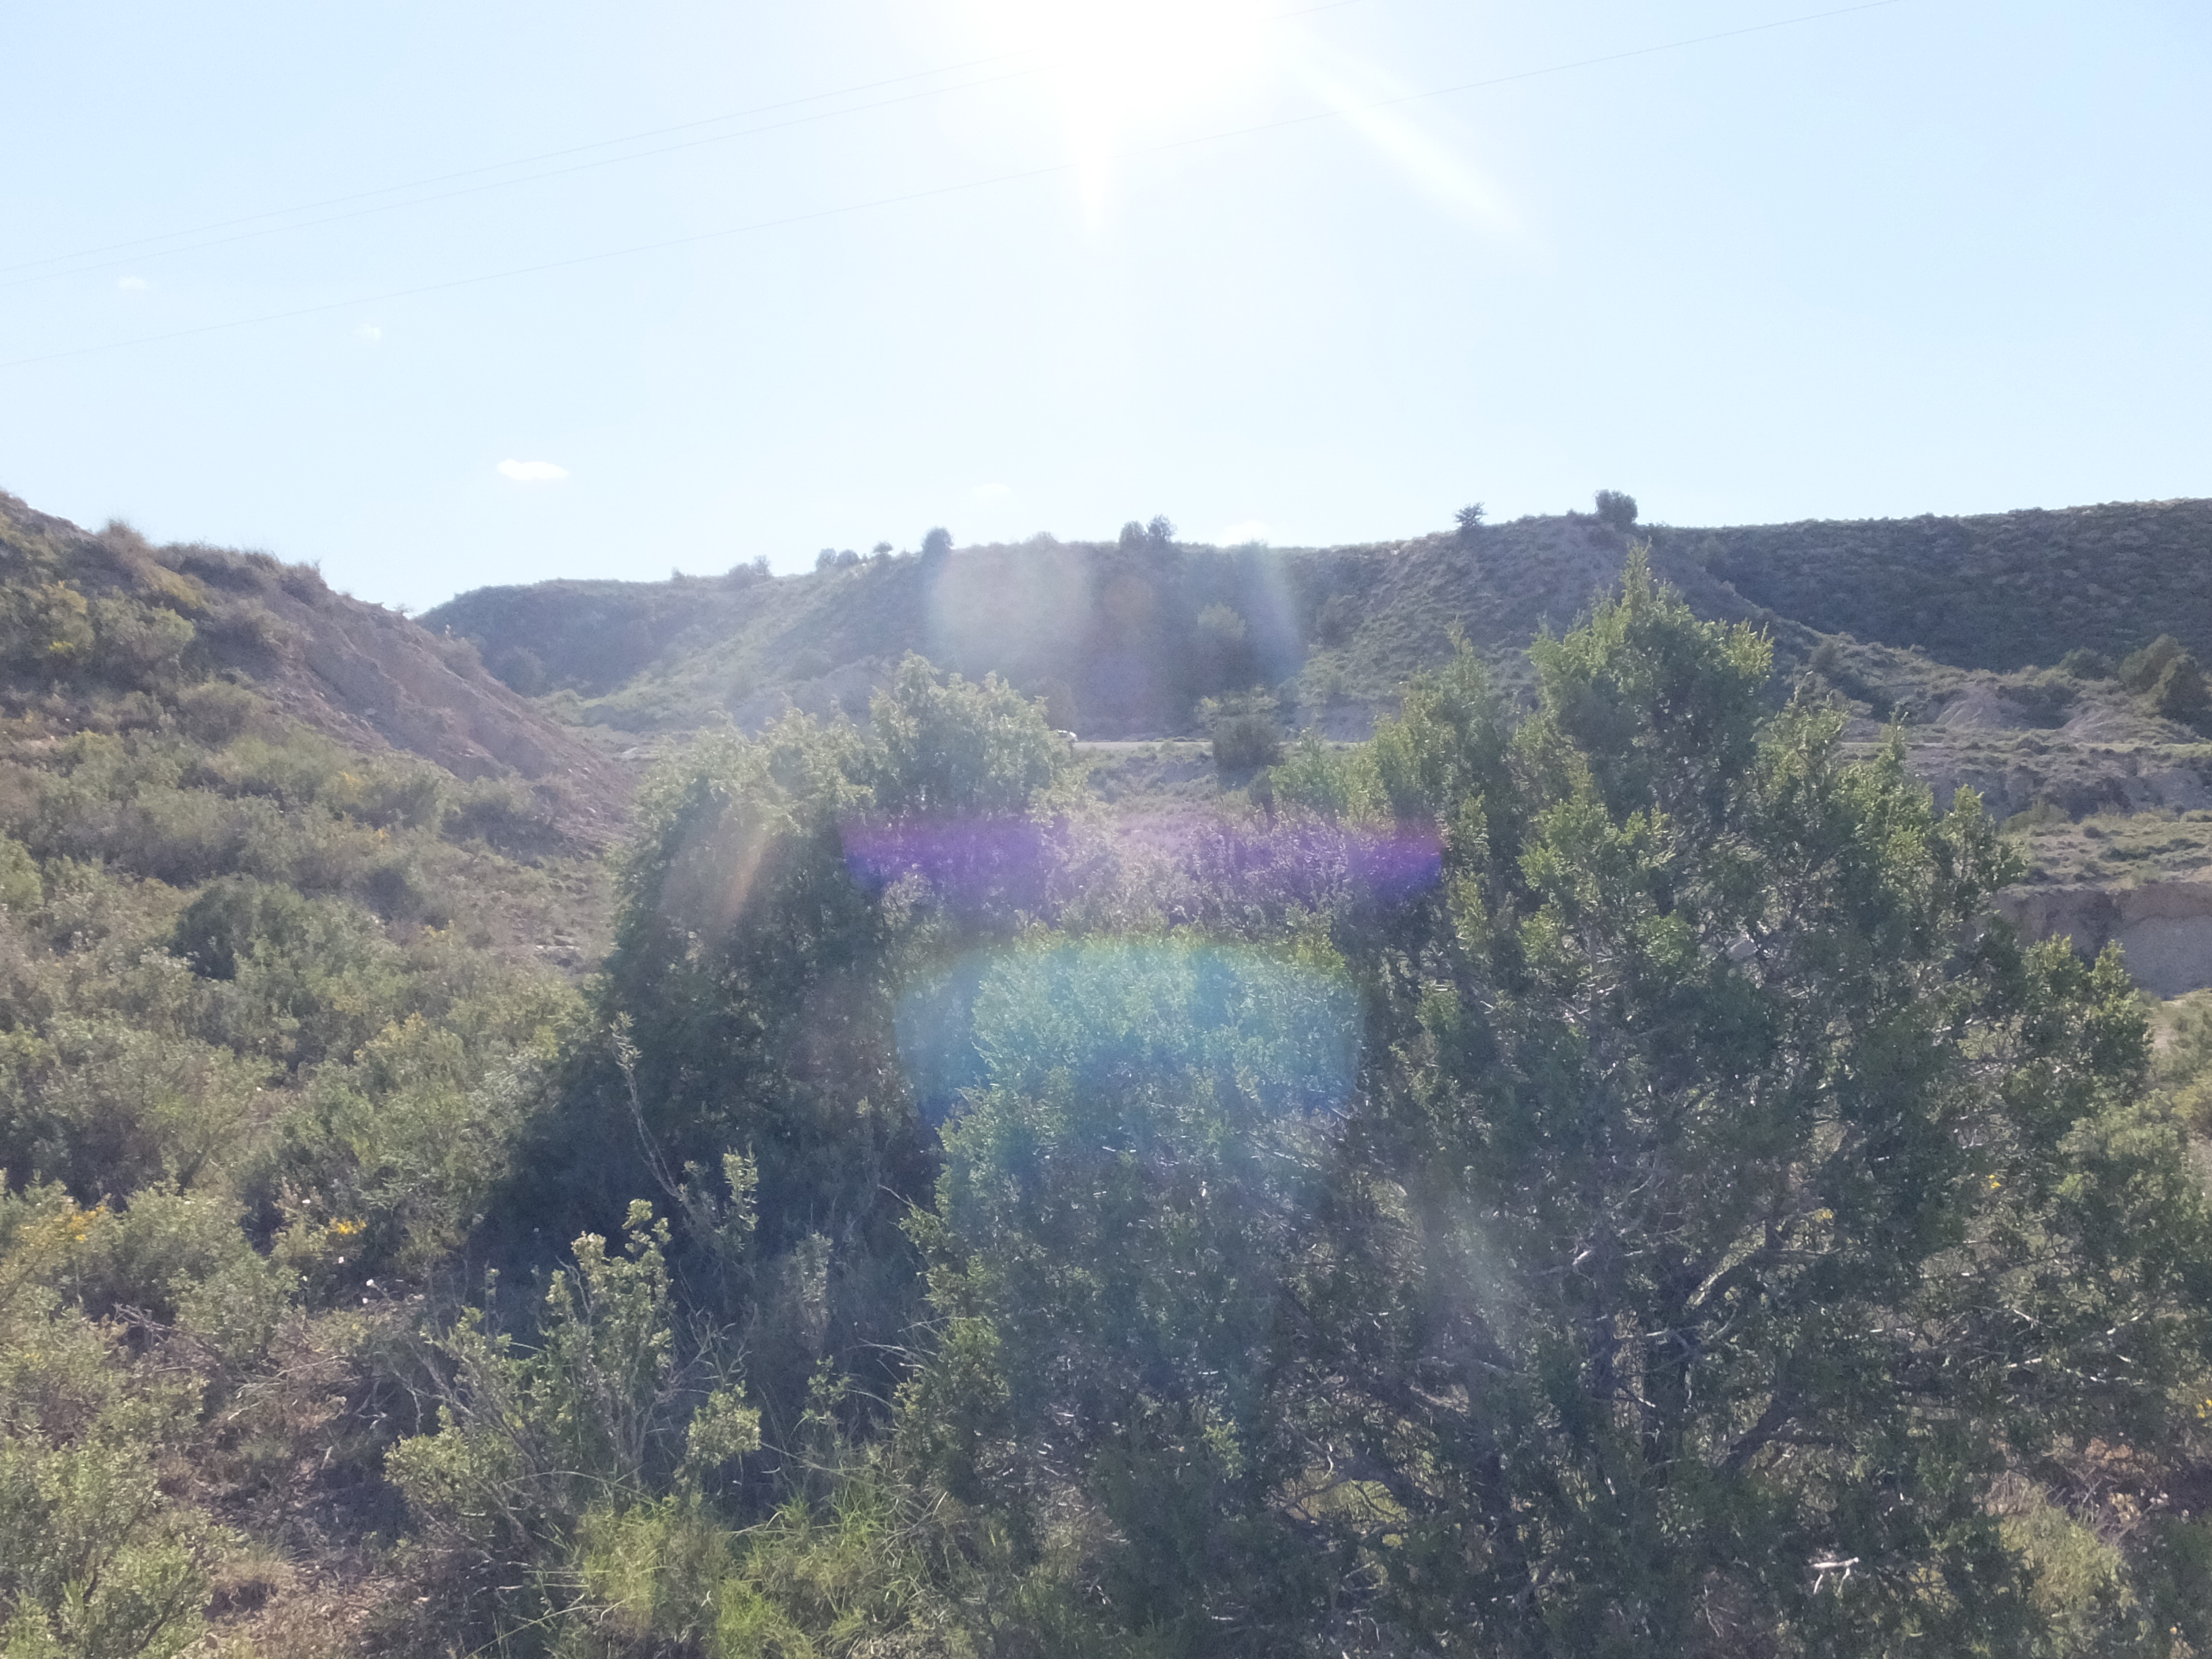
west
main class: Shrubland
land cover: Shrubland with sparse tree cover
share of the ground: > 75 %
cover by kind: shrubs 90 %, coniferous forest trees 5 %, herbaceous plants 5 %
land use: Abandoned areas
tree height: < 5 m
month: April
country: ES
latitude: 41.6813
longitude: -0.2165
